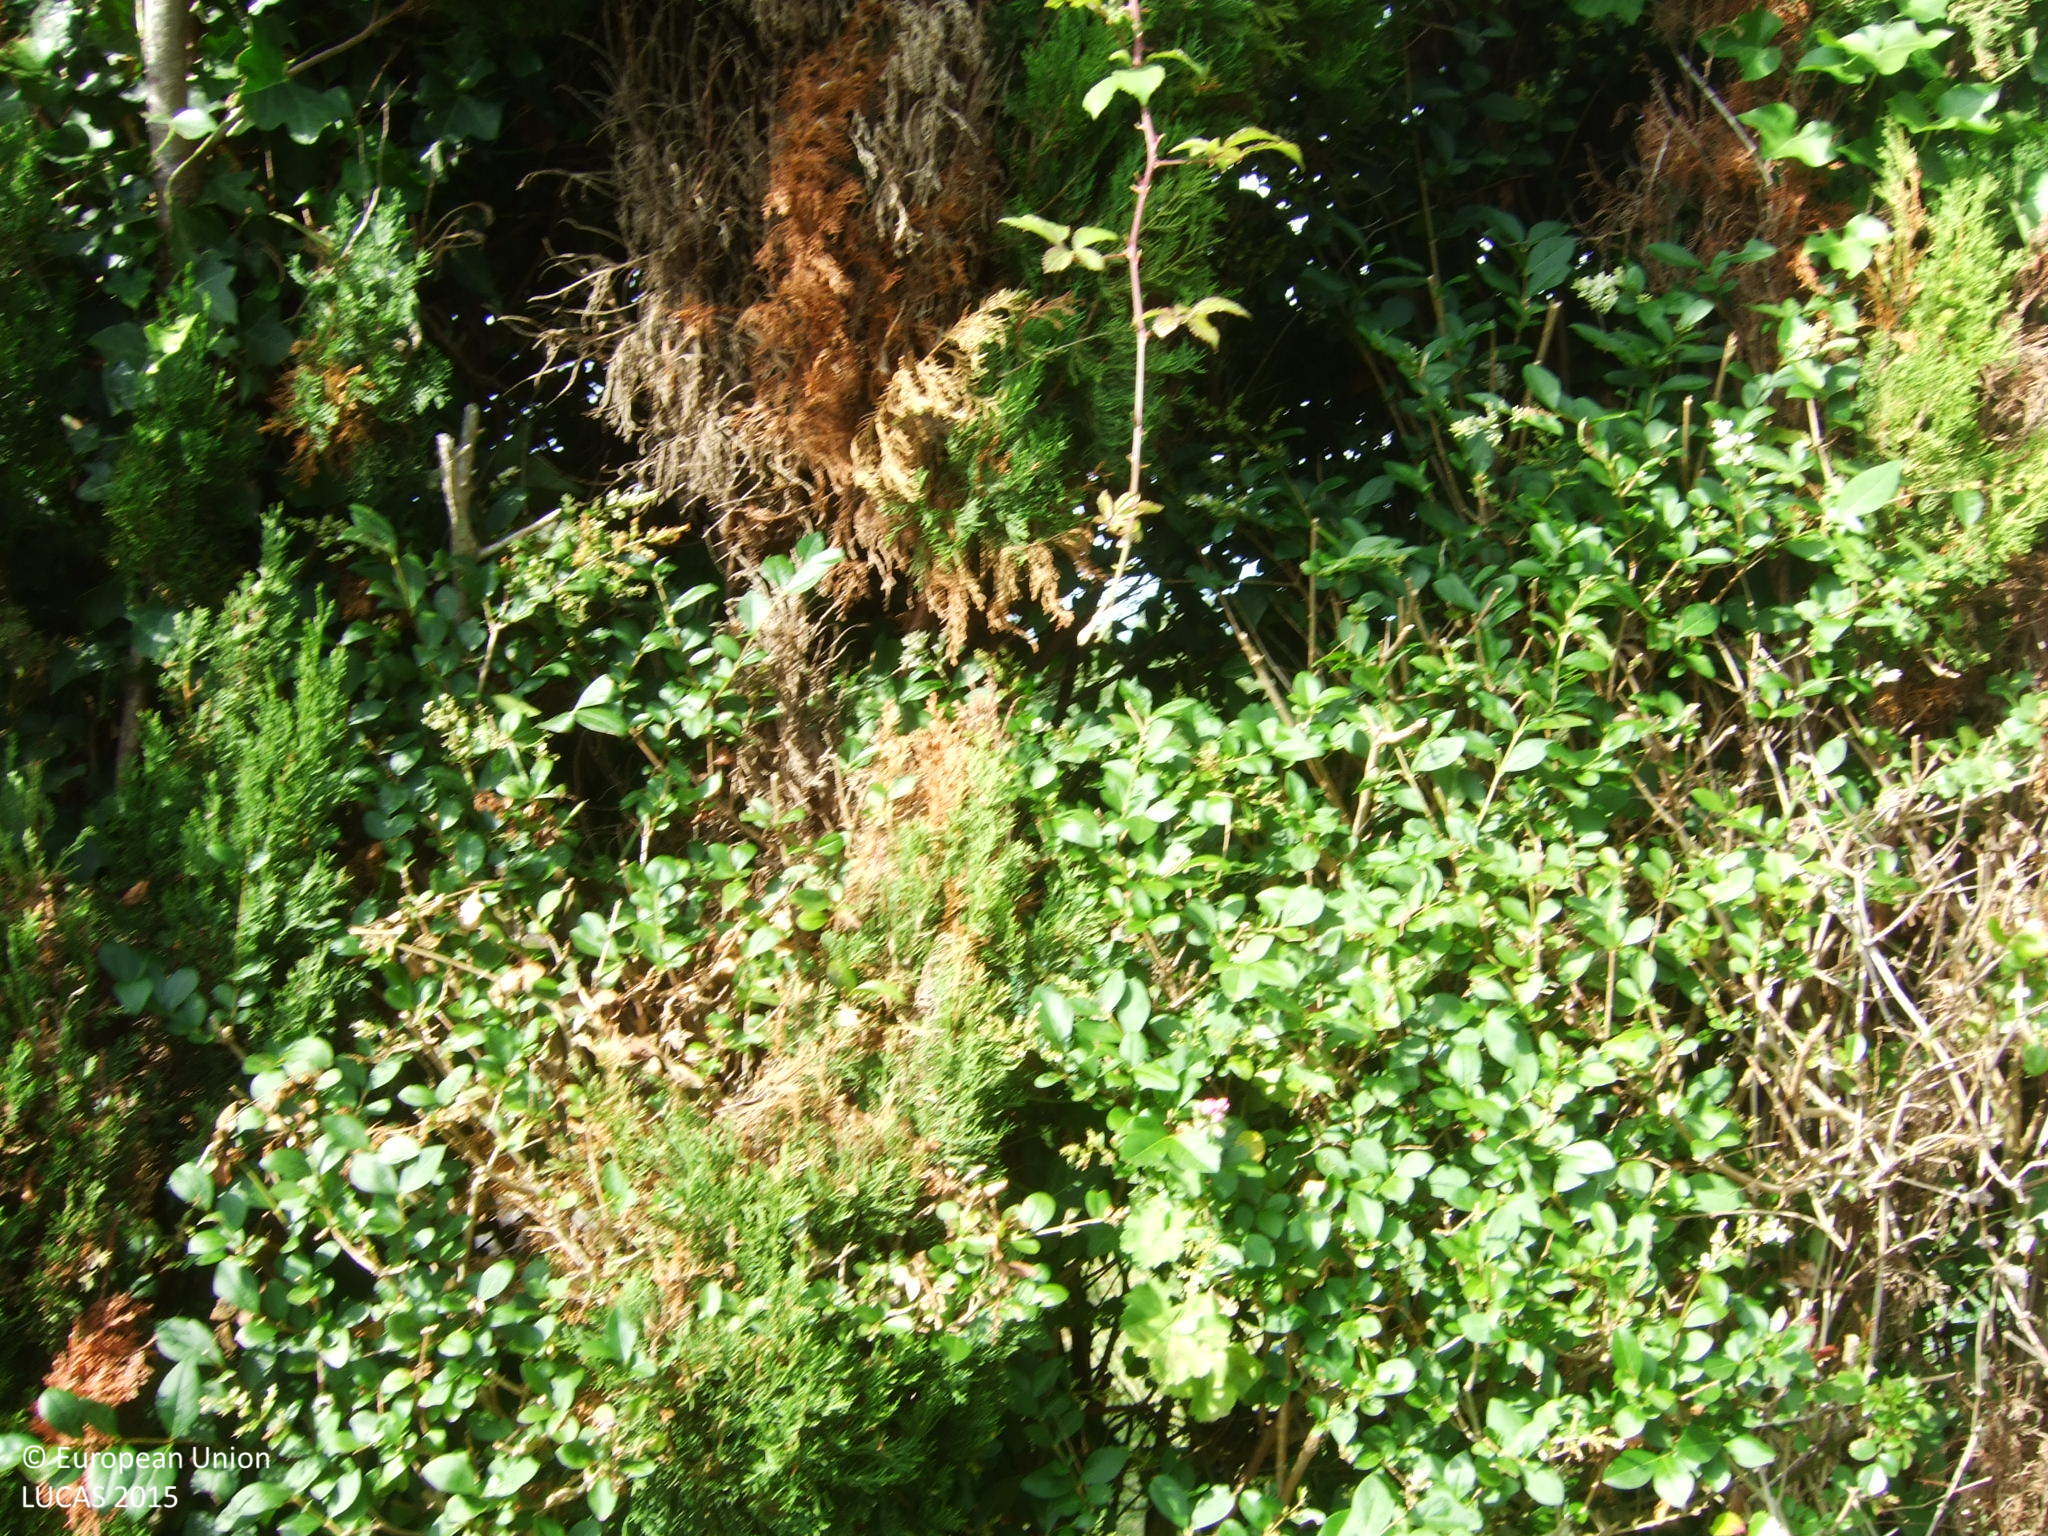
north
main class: Grassland
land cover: Grassland without tree/shrub cover
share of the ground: > 75 %
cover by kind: herbaceous plants 100 %
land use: Agriculture (excluding fallow land and kitchen gardens)
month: June
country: ES
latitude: 43.6945
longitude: -7.6189
